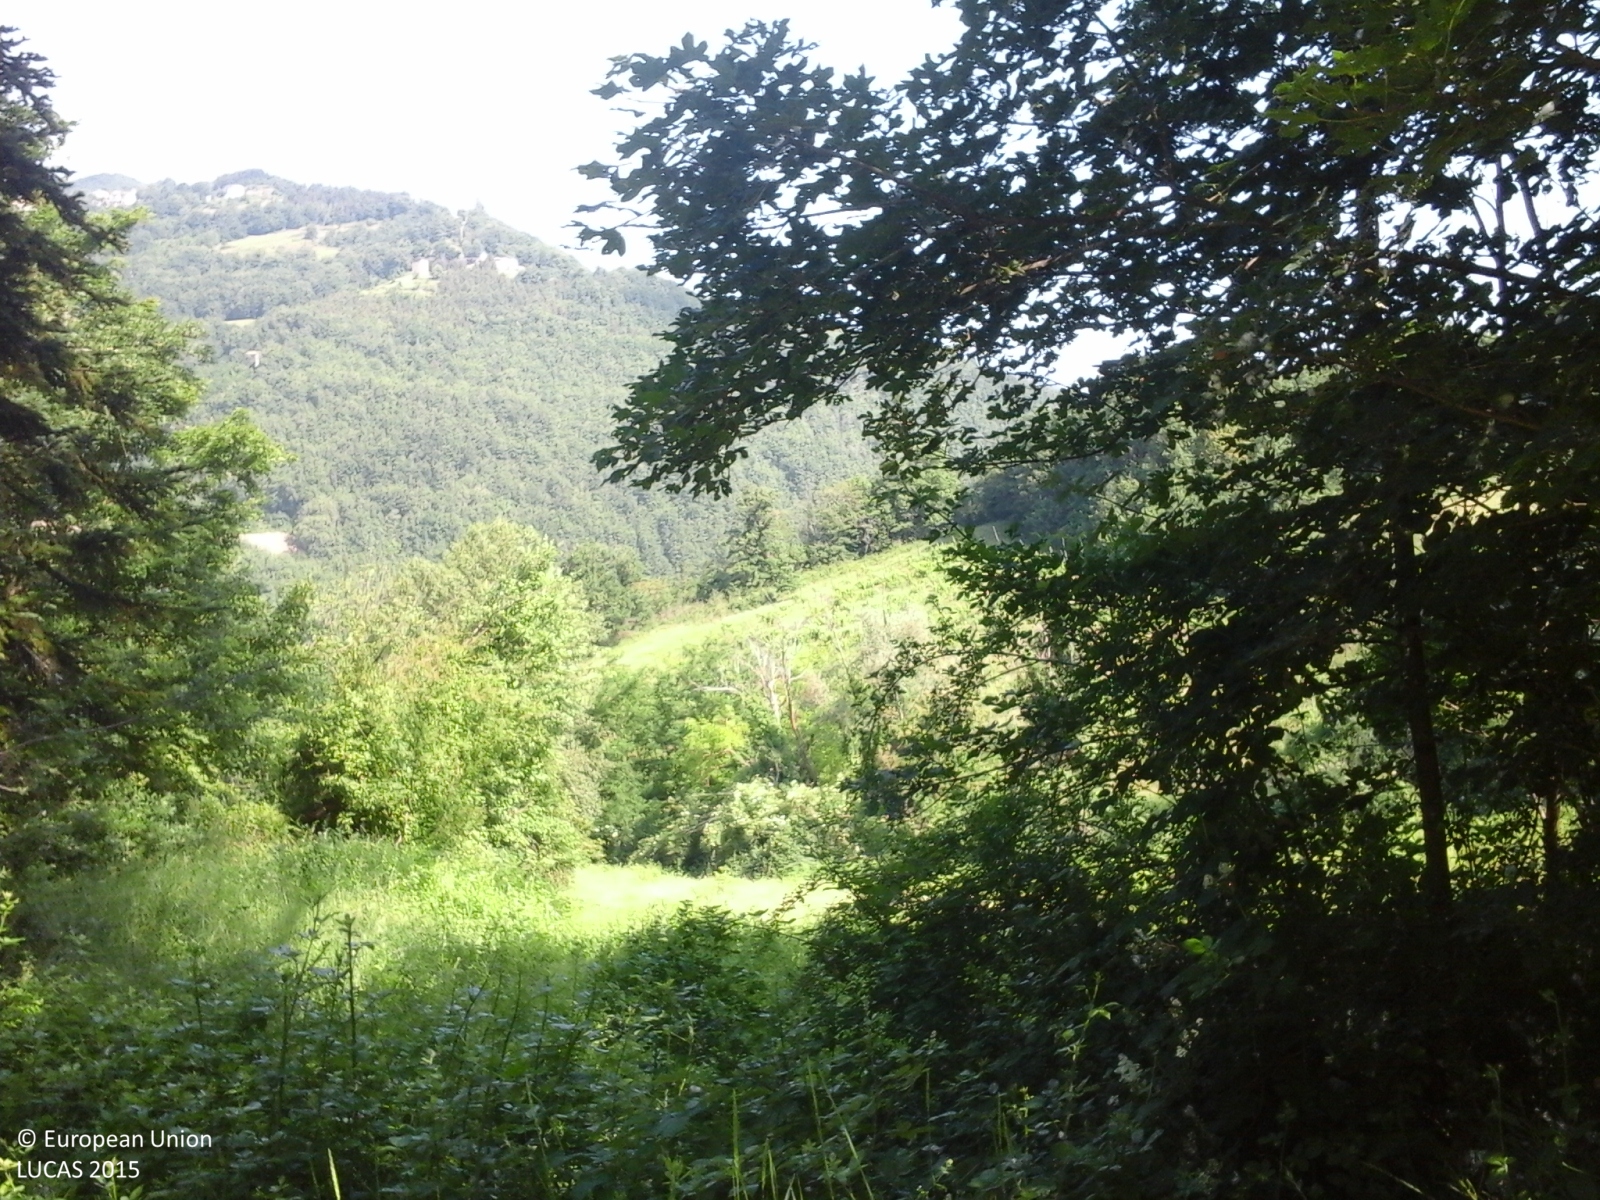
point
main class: Grassland
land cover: Grassland without tree/shrub cover
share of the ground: > 75 %
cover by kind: herbaceous plants 100 %
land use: Semi-natural and natural areas not in use
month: June
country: IT
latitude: 44.3306
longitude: 10.6381
